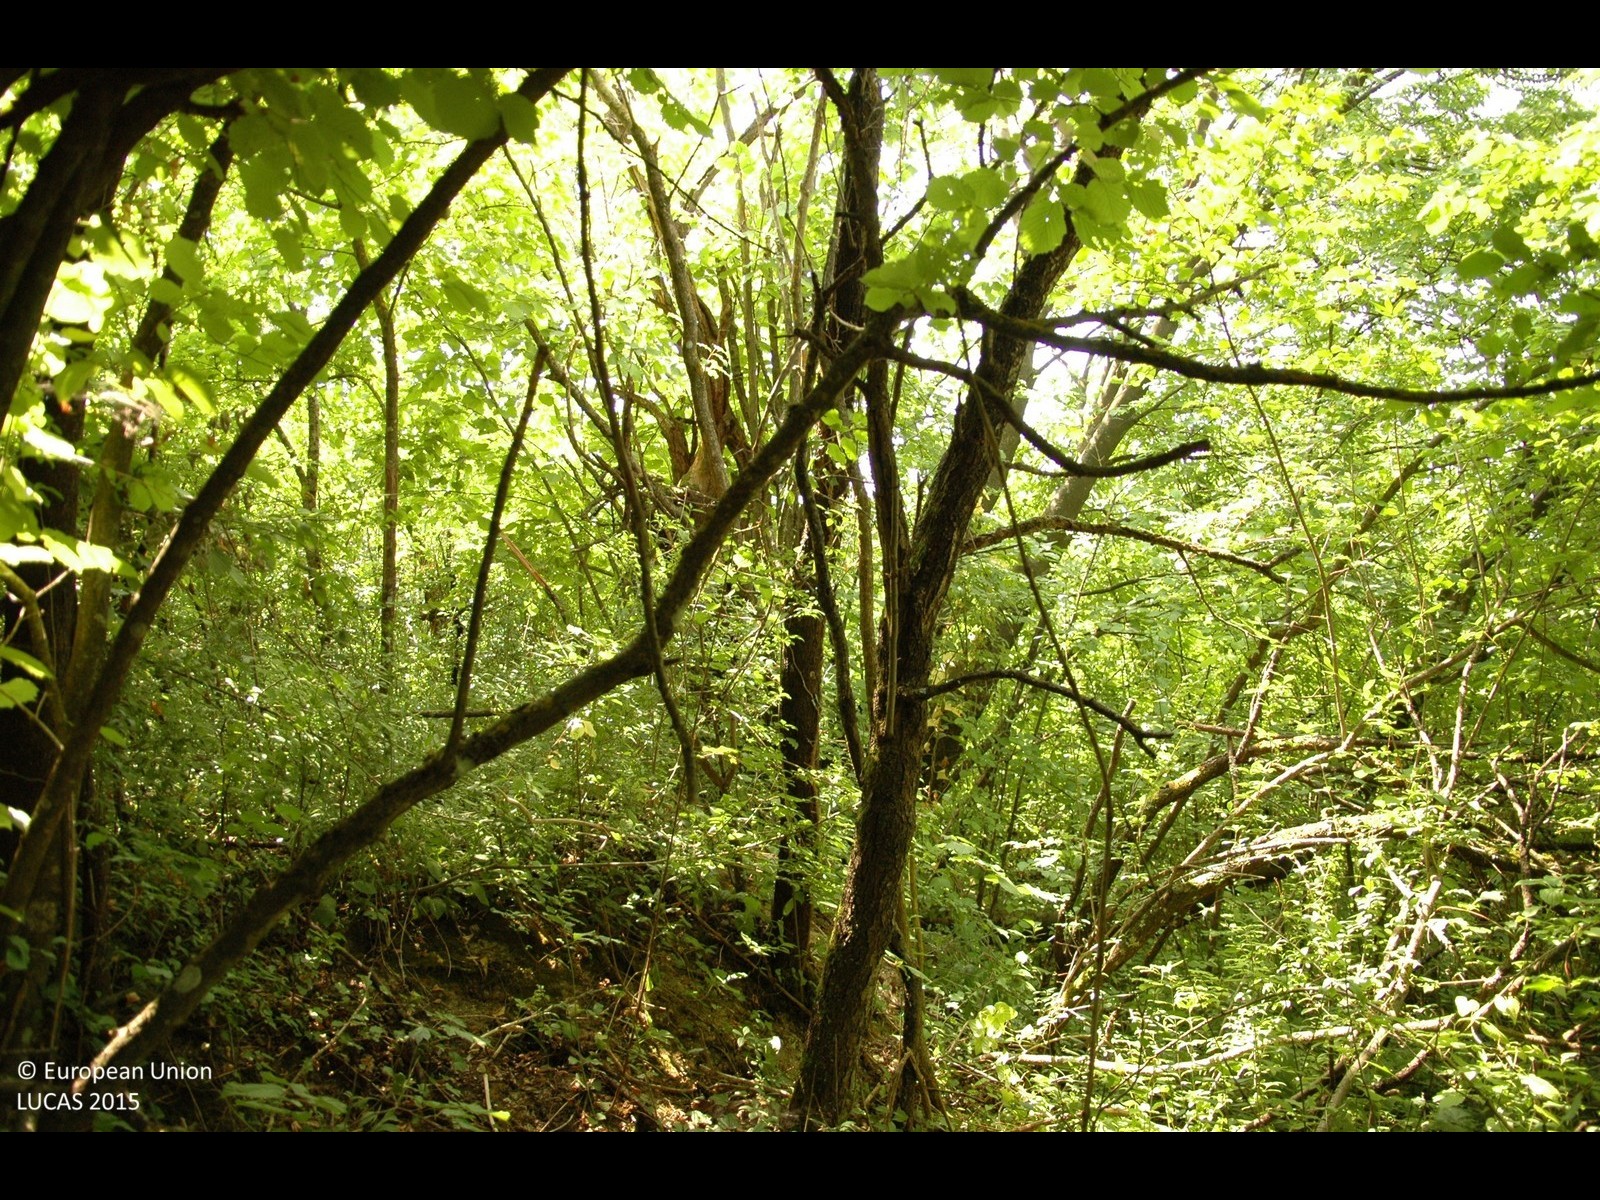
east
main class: Shrubland
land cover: Shrubland without tree cover
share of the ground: > 75 %
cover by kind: shrubs 100 %
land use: Semi-natural and natural areas not in use
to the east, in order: Shrubland without tree cover; Grassland without tree/shrub cover; Vineyards; Maize; Spontaneously vegetated surfaces; Spruce dominated coniferous woodland; Broadleaved woodland; Tracks; Broadleaved woodland
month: July
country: HR
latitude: 46.1479
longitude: 16.5904
